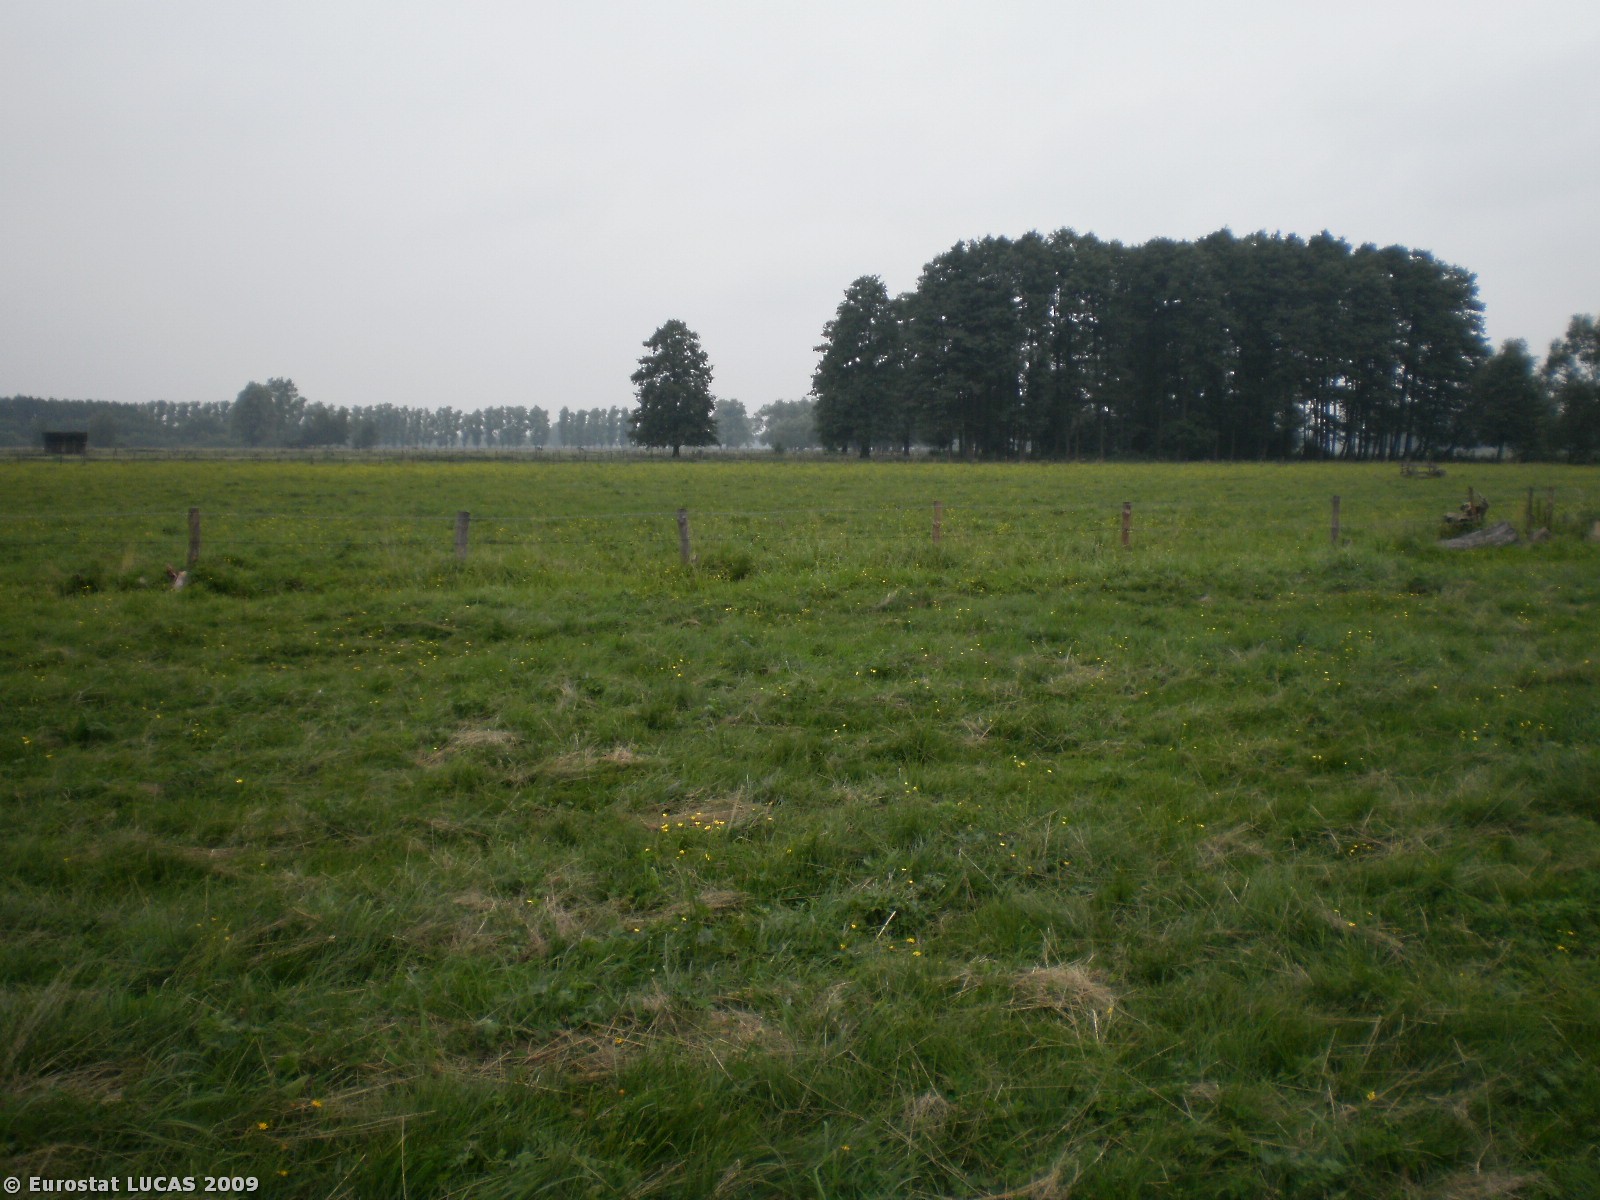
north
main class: Grassland
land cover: Grassland without tree/shrub cover
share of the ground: > 75 %
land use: Agriculture (excluding fallow land and kitchen gardens)
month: August
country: PL
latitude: 53.1474
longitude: 21.0639
